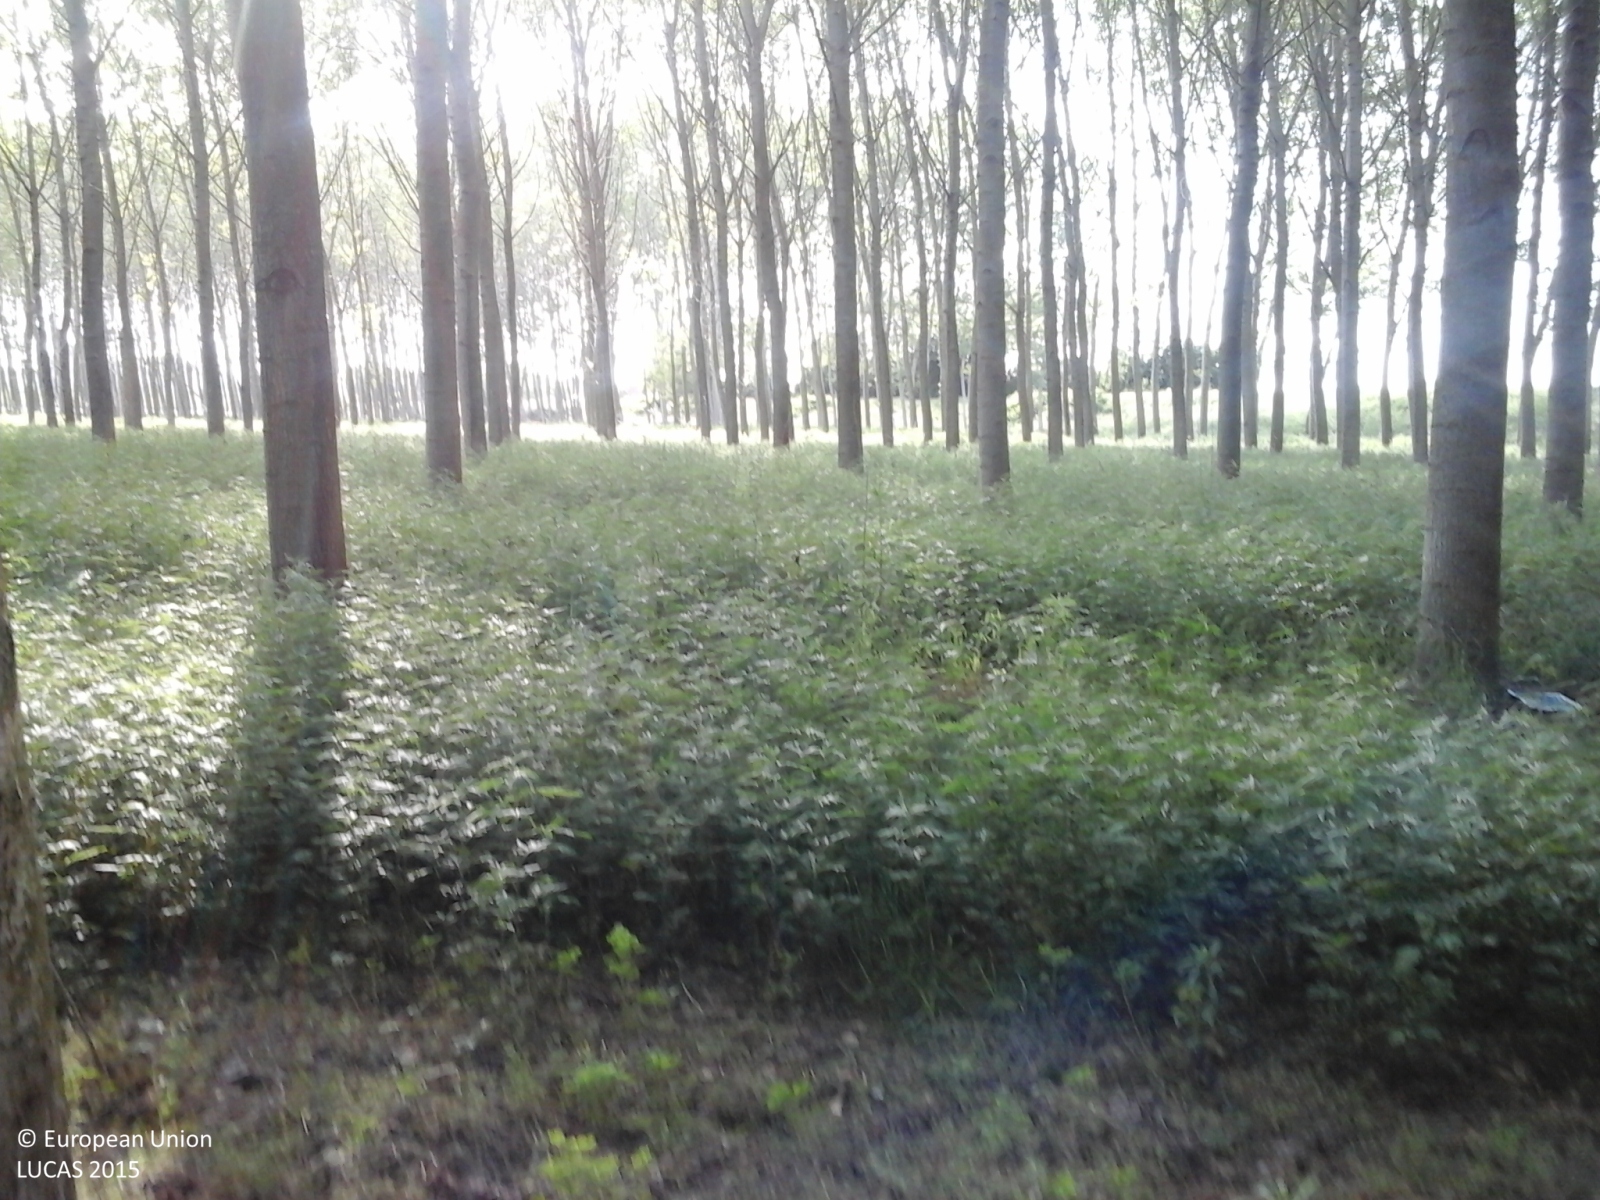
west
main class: Woodland
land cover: Broadleaved woodland
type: non-riverine alder, birch or aspen forest
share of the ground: > 75 %
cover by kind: broadleaved forest trees 80 %, herbaceous plants 20 %
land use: Forestry
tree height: > 5 m
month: May
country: IT
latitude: 45.1810
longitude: 8.1072
